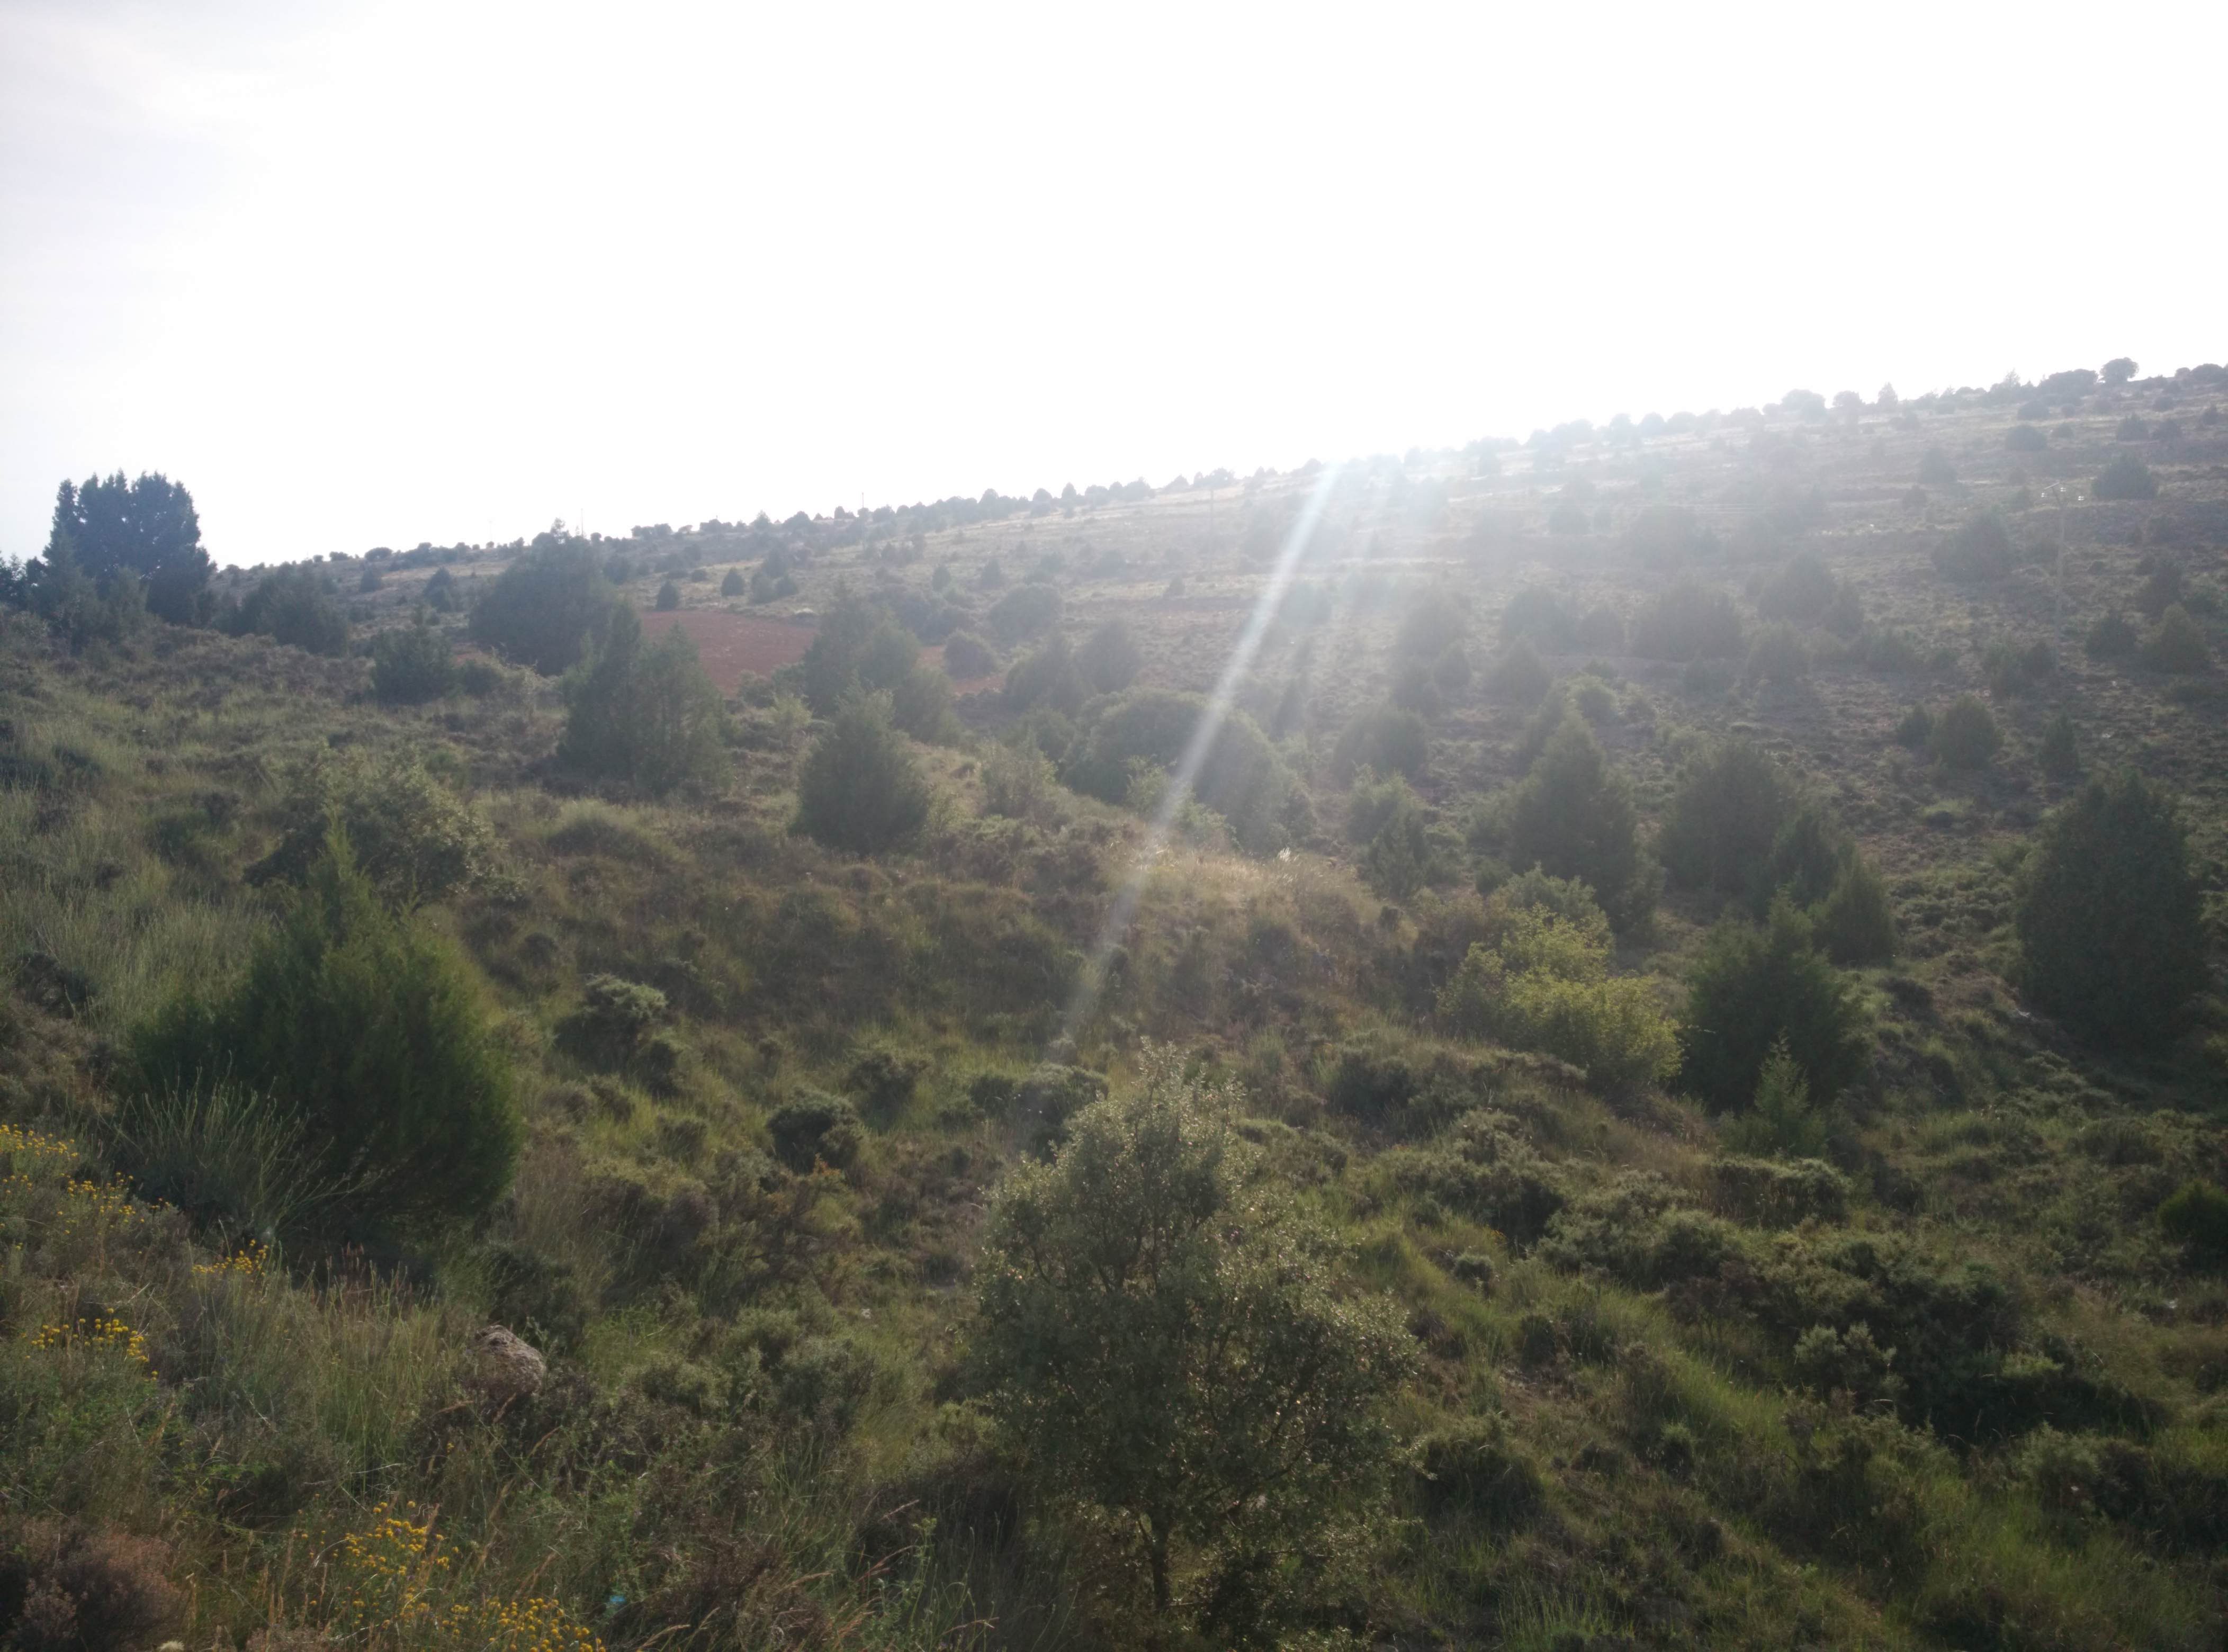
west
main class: Shrubland
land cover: Shrubland with sparse tree cover
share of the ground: > 75 %
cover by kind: shrubs 80 %, unconsolidated bare surface 15 %, coniferous forest trees 5 %
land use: Semi-natural and natural areas not in use
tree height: < 5 m
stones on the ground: 10 - 25 %
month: July
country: ES
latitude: 41.0752
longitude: -1.8910
